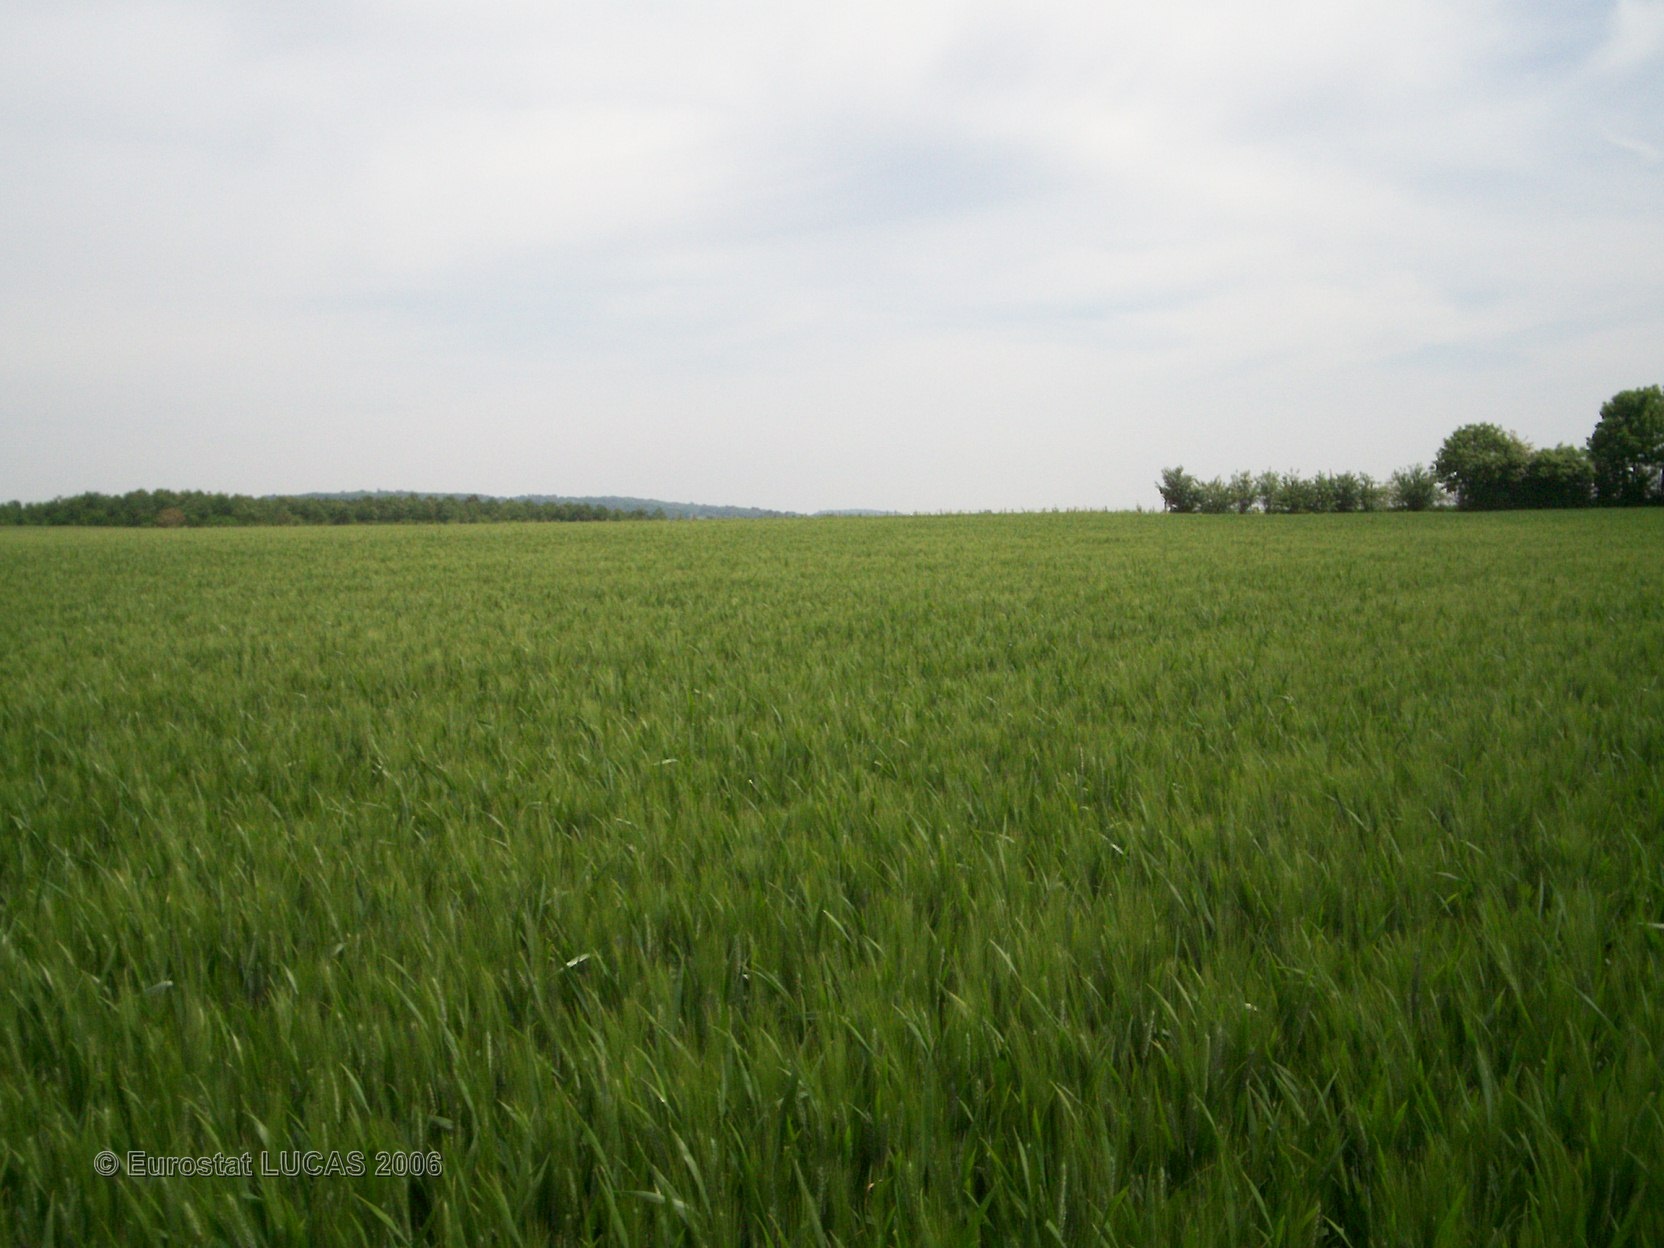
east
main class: Cropland
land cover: Barley
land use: Agriculture (excluding fallow land and kitchen gardens)
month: May
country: FR
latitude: 46.6678
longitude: -0.8666
